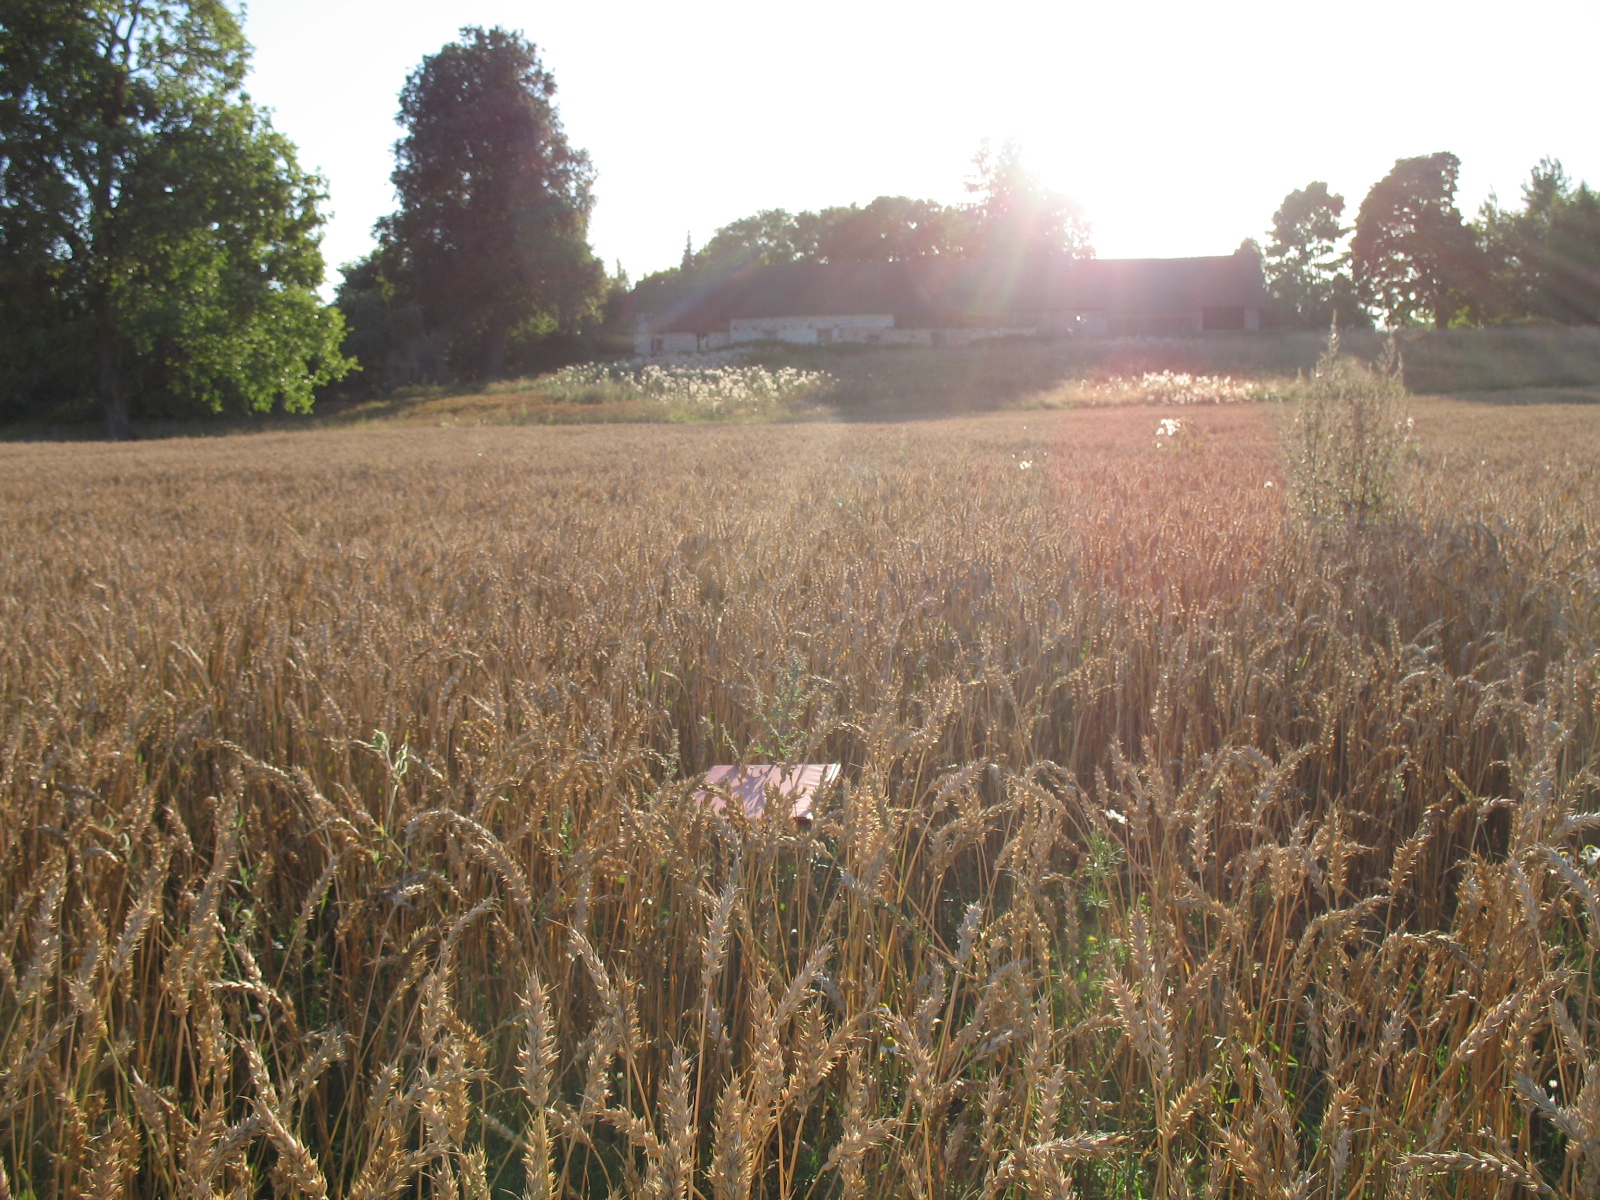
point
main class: Cropland
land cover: Common wheat
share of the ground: > 75 %
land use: Agriculture (excluding fallow land and kitchen gardens)
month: August
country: LV
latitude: 56.5653
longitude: 25.5984
